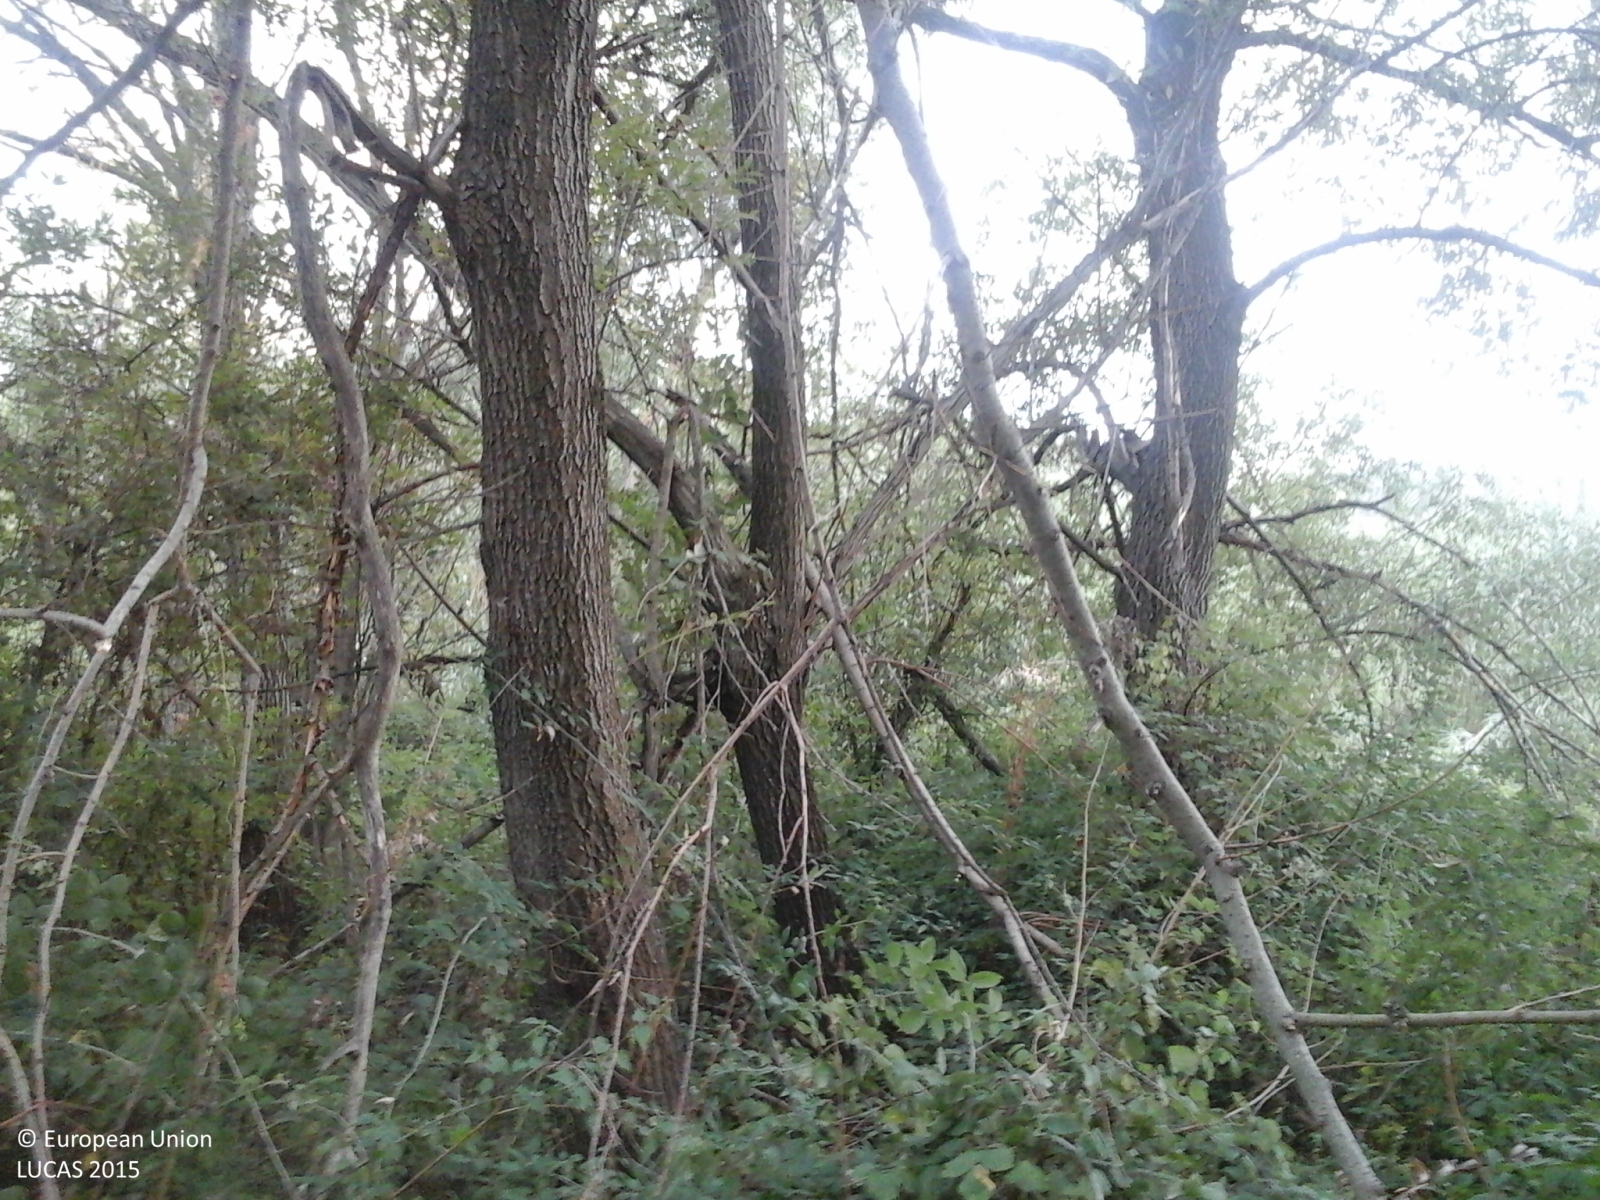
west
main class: Woodland
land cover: Broadleaved woodland
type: thermophilous deciduous forest
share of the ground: > 75 %
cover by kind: broadleaved forest trees 80 %, shrubs 15 %, herbaceous plants 5 %
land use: Semi-natural and natural areas not in use
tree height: > 5 m
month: September
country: IT
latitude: 42.5664
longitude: 13.7529
